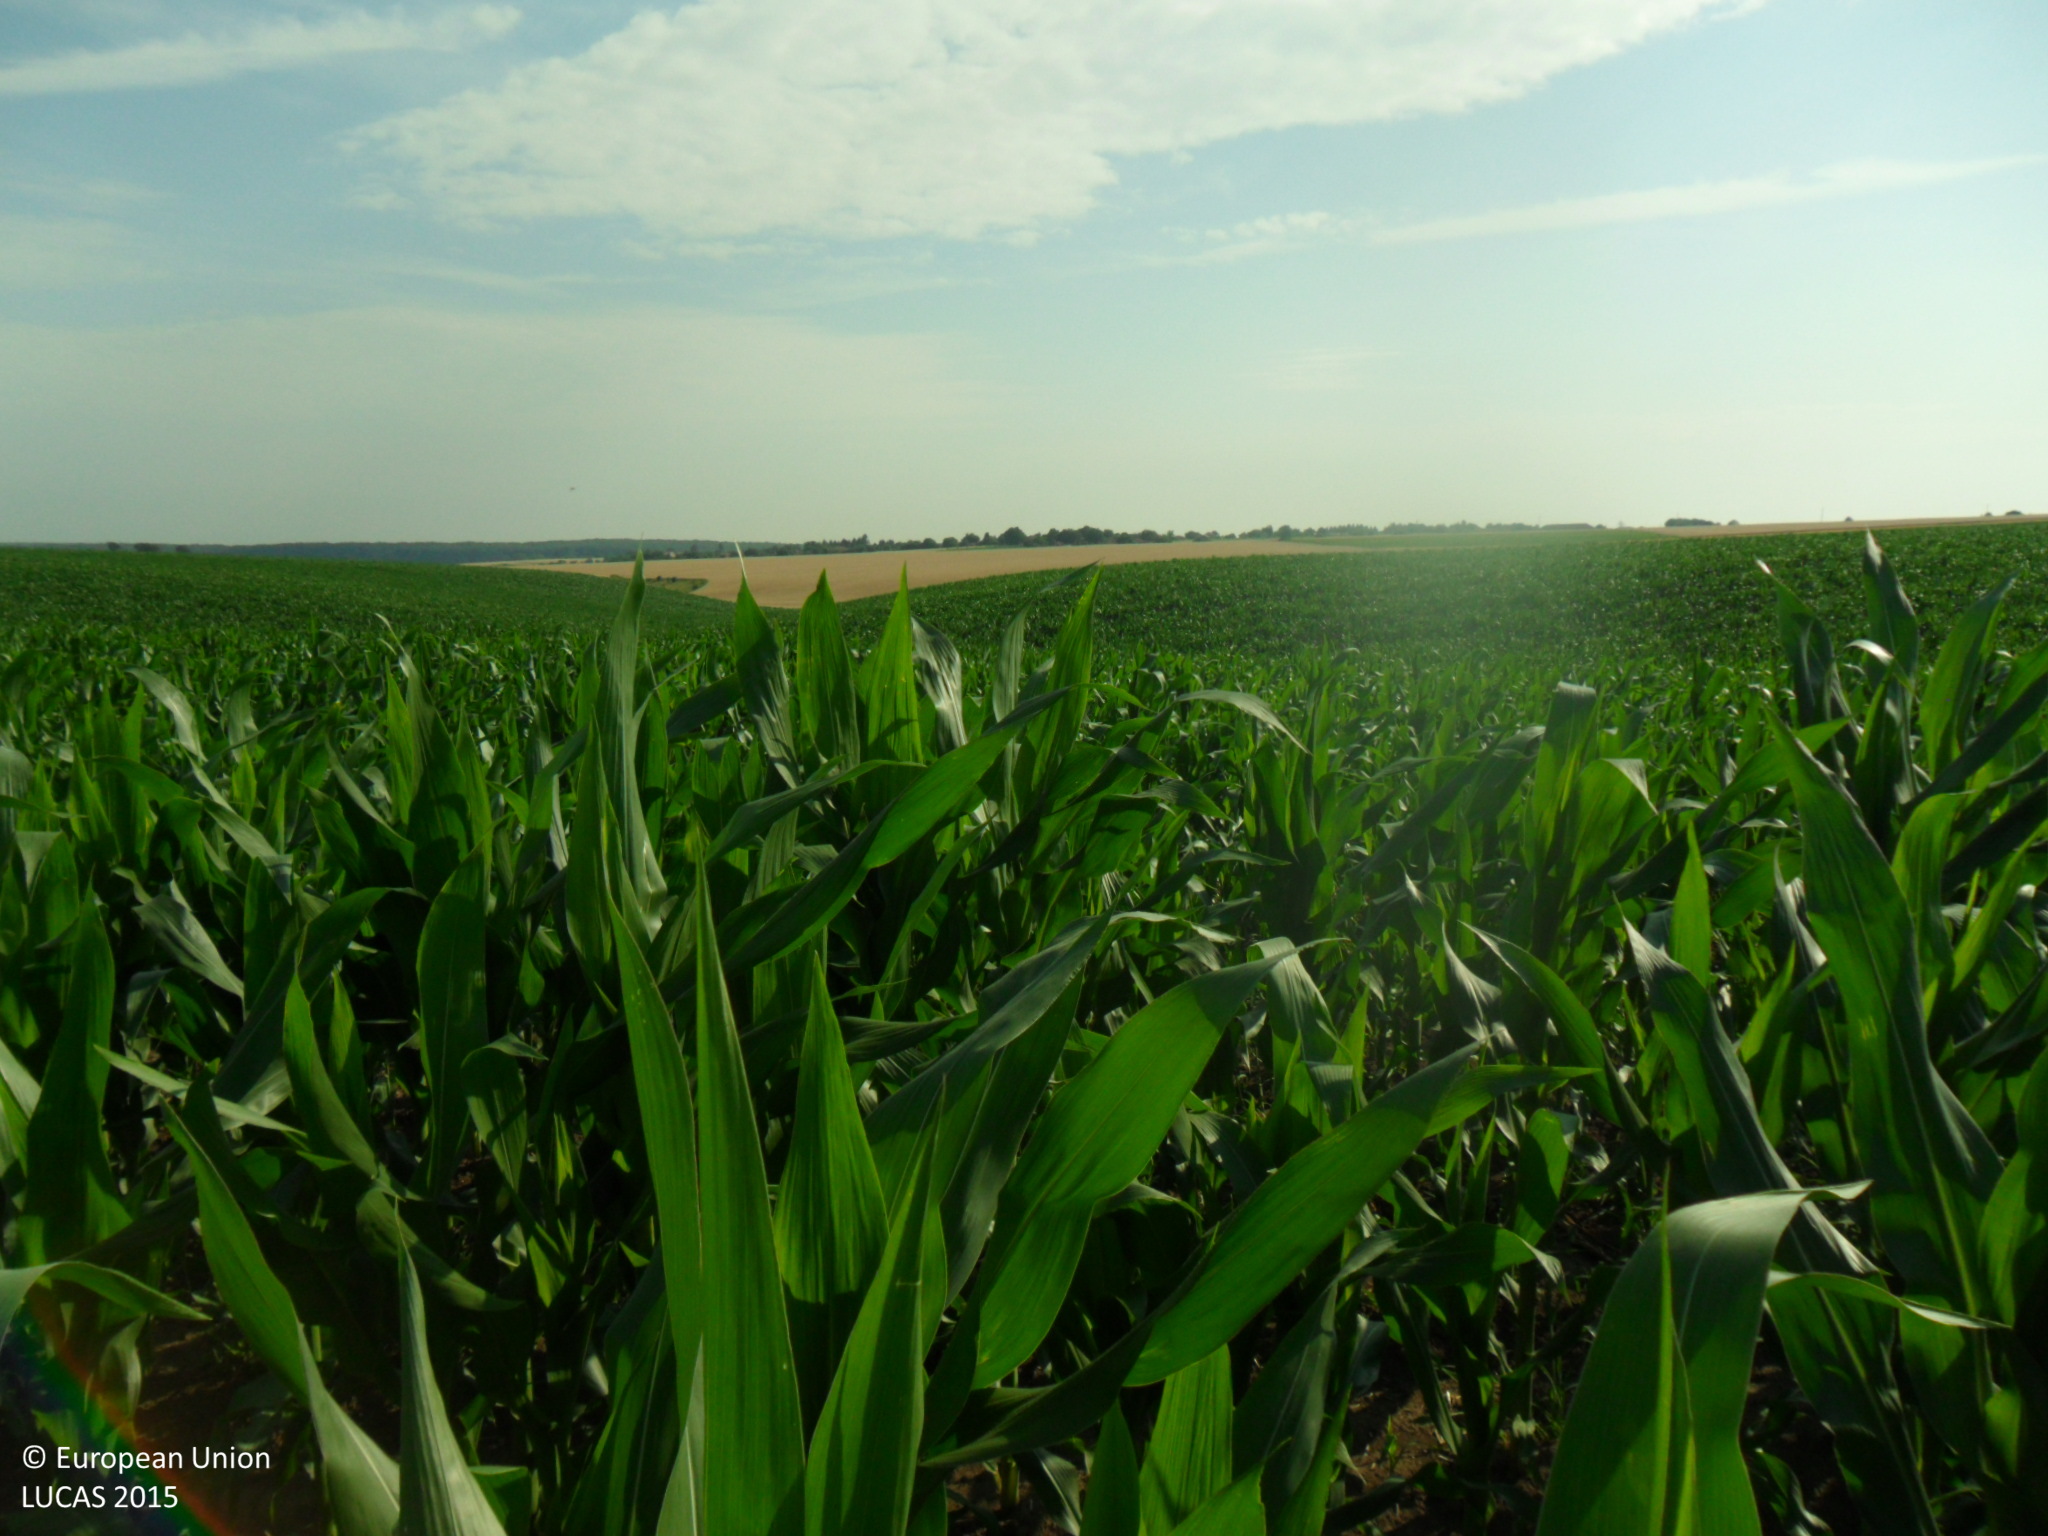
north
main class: Cropland
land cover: Maize
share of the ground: > 75 %
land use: Agriculture (excluding fallow land and kitchen gardens)
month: July
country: BG
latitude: 43.6417
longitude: 26.7359
